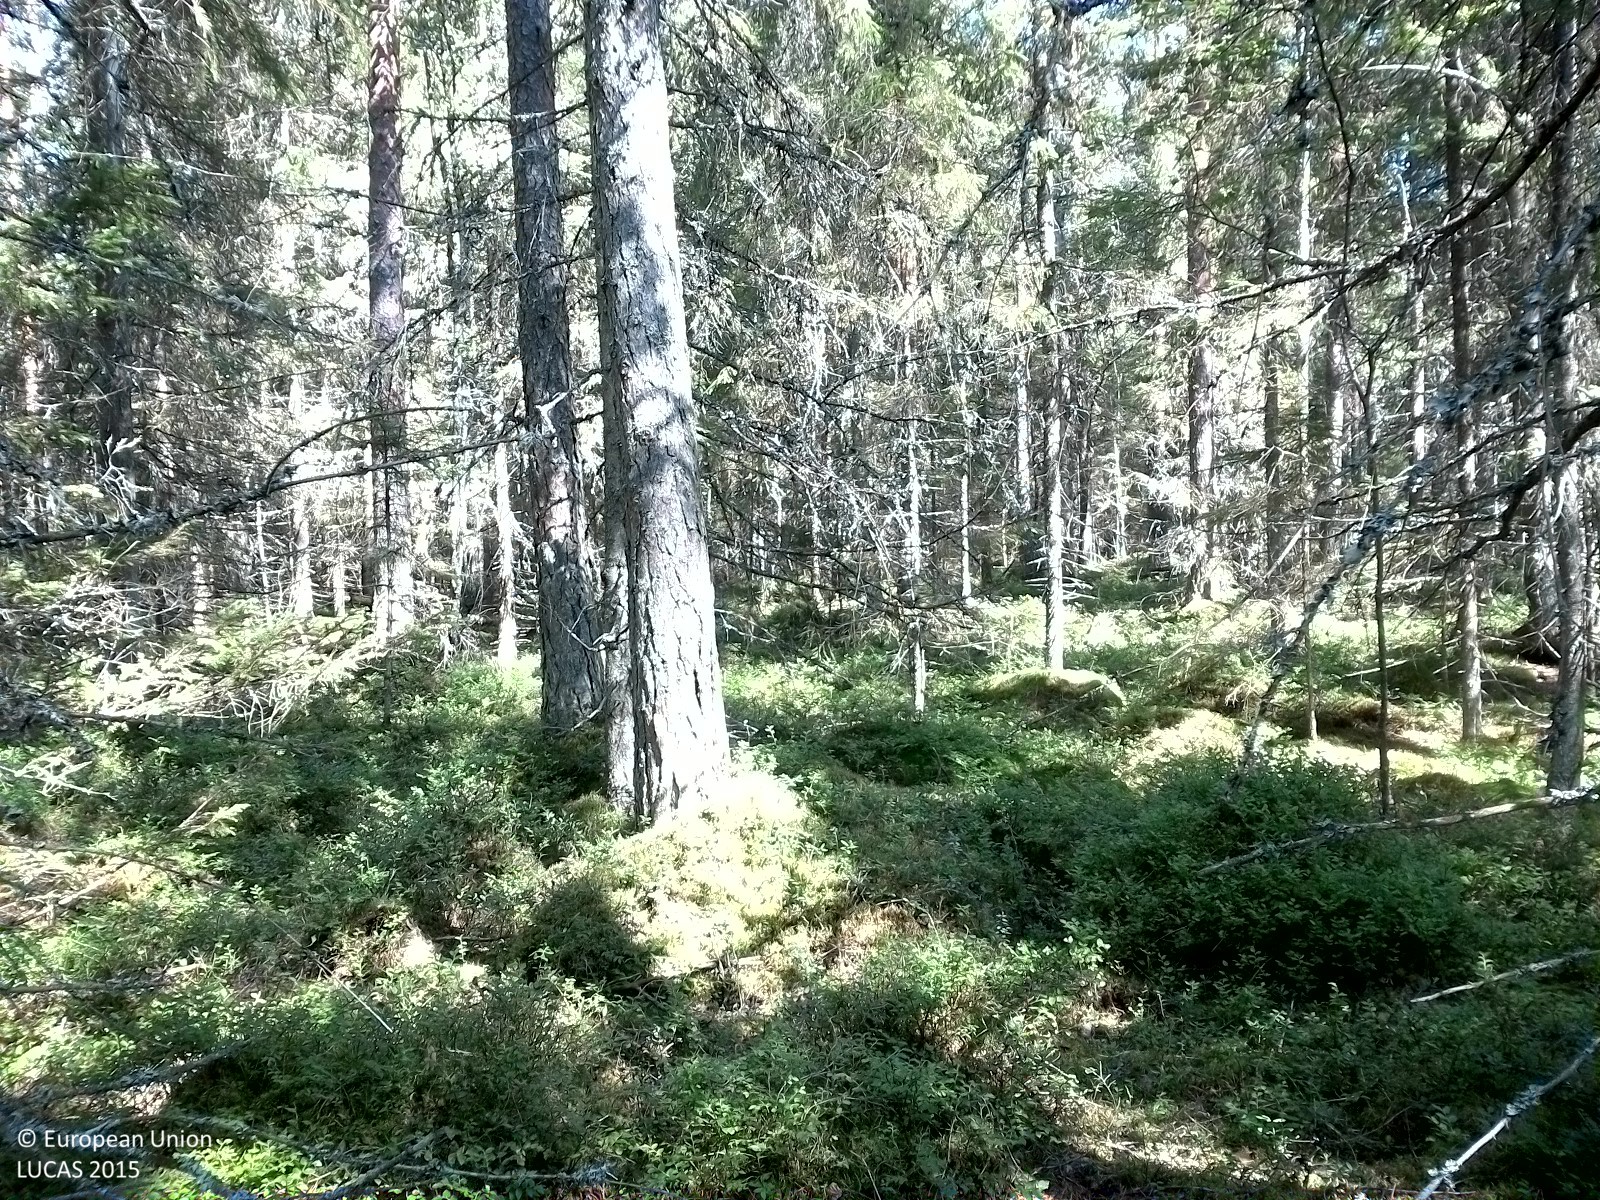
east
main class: Woodland
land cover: Pine dominated coniferous woodland
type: boreal forest
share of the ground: 25 - 50 %
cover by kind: coniferous forest trees 40 %, herbaceous plants 40 %, lichens and mosses 20 %
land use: Forestry
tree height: > 5 m
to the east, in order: Pine dominated coniferous woodland; Ditches and canals; Pine dominated coniferous woodland; Spruce dominated coniferous woodland
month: August
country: SE
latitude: 58.9408
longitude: 15.3972
